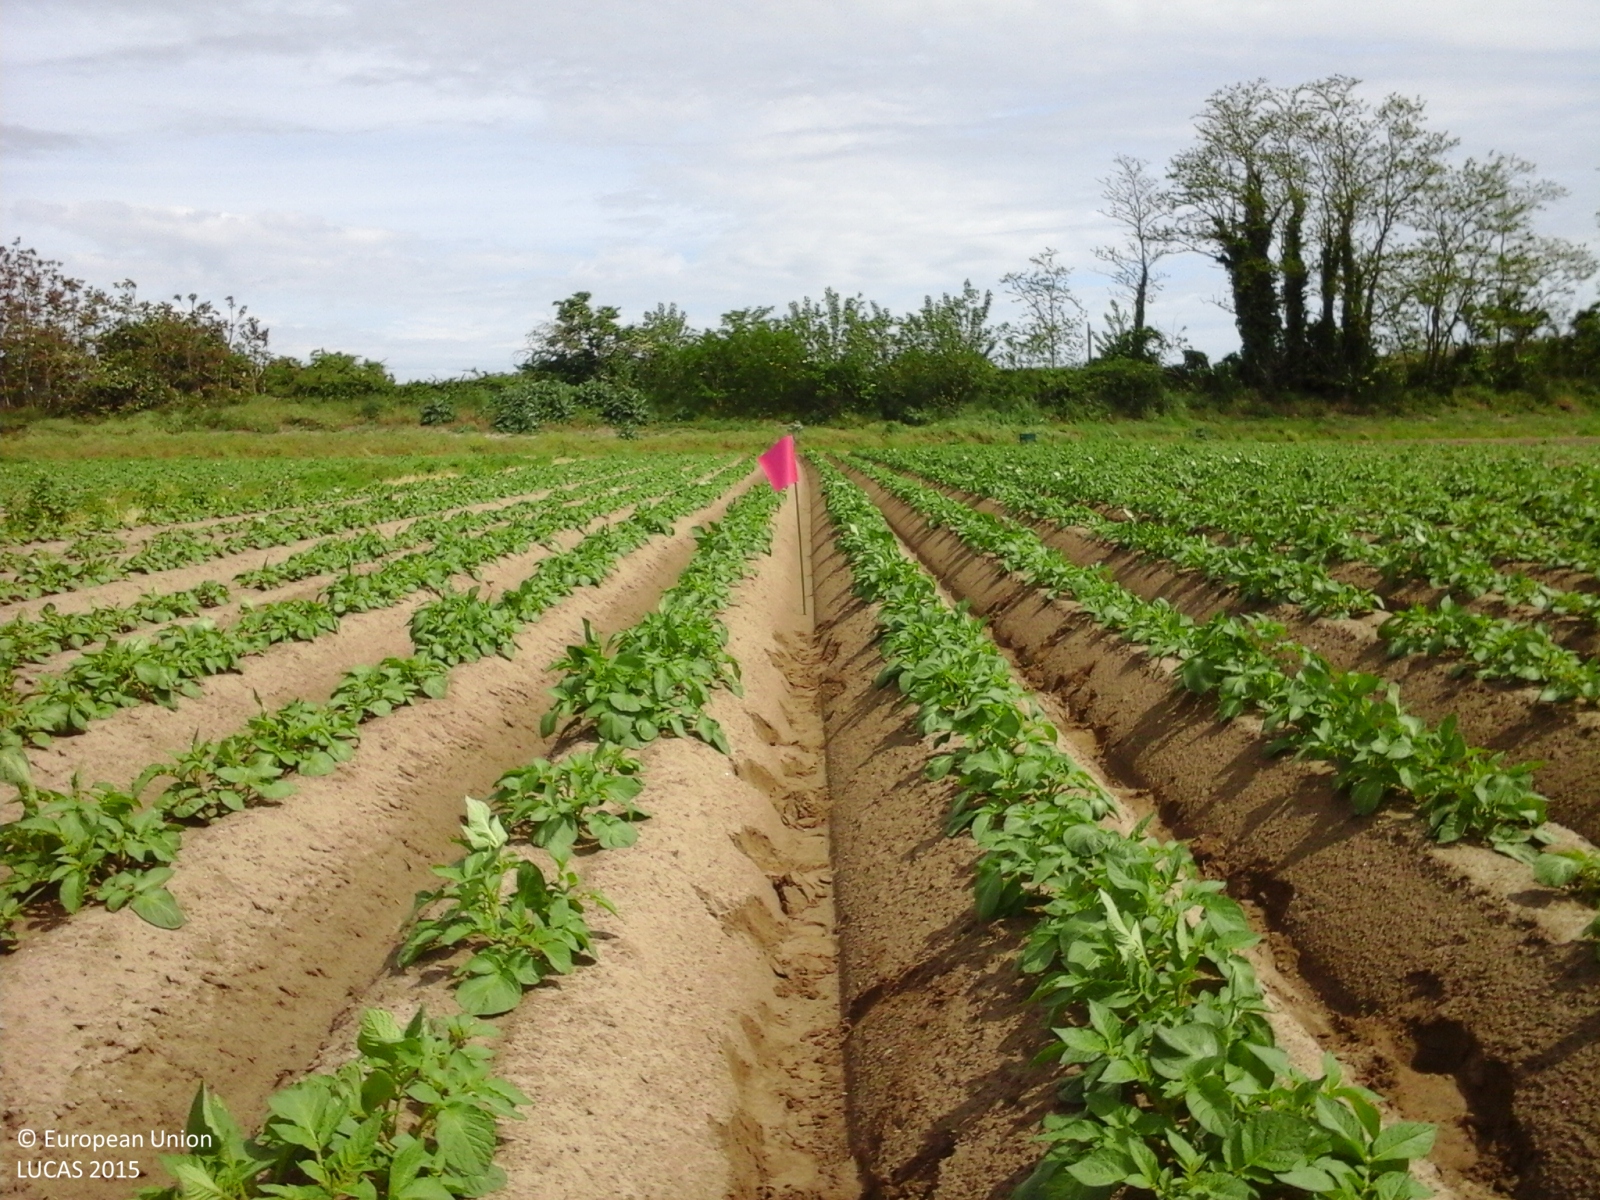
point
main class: Cropland
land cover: Potatoes
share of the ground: 25 - 50 %
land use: Agriculture (excluding fallow land and kitchen gardens)
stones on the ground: < 10 %
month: April
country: IT
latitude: 44.8867
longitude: 12.1862
